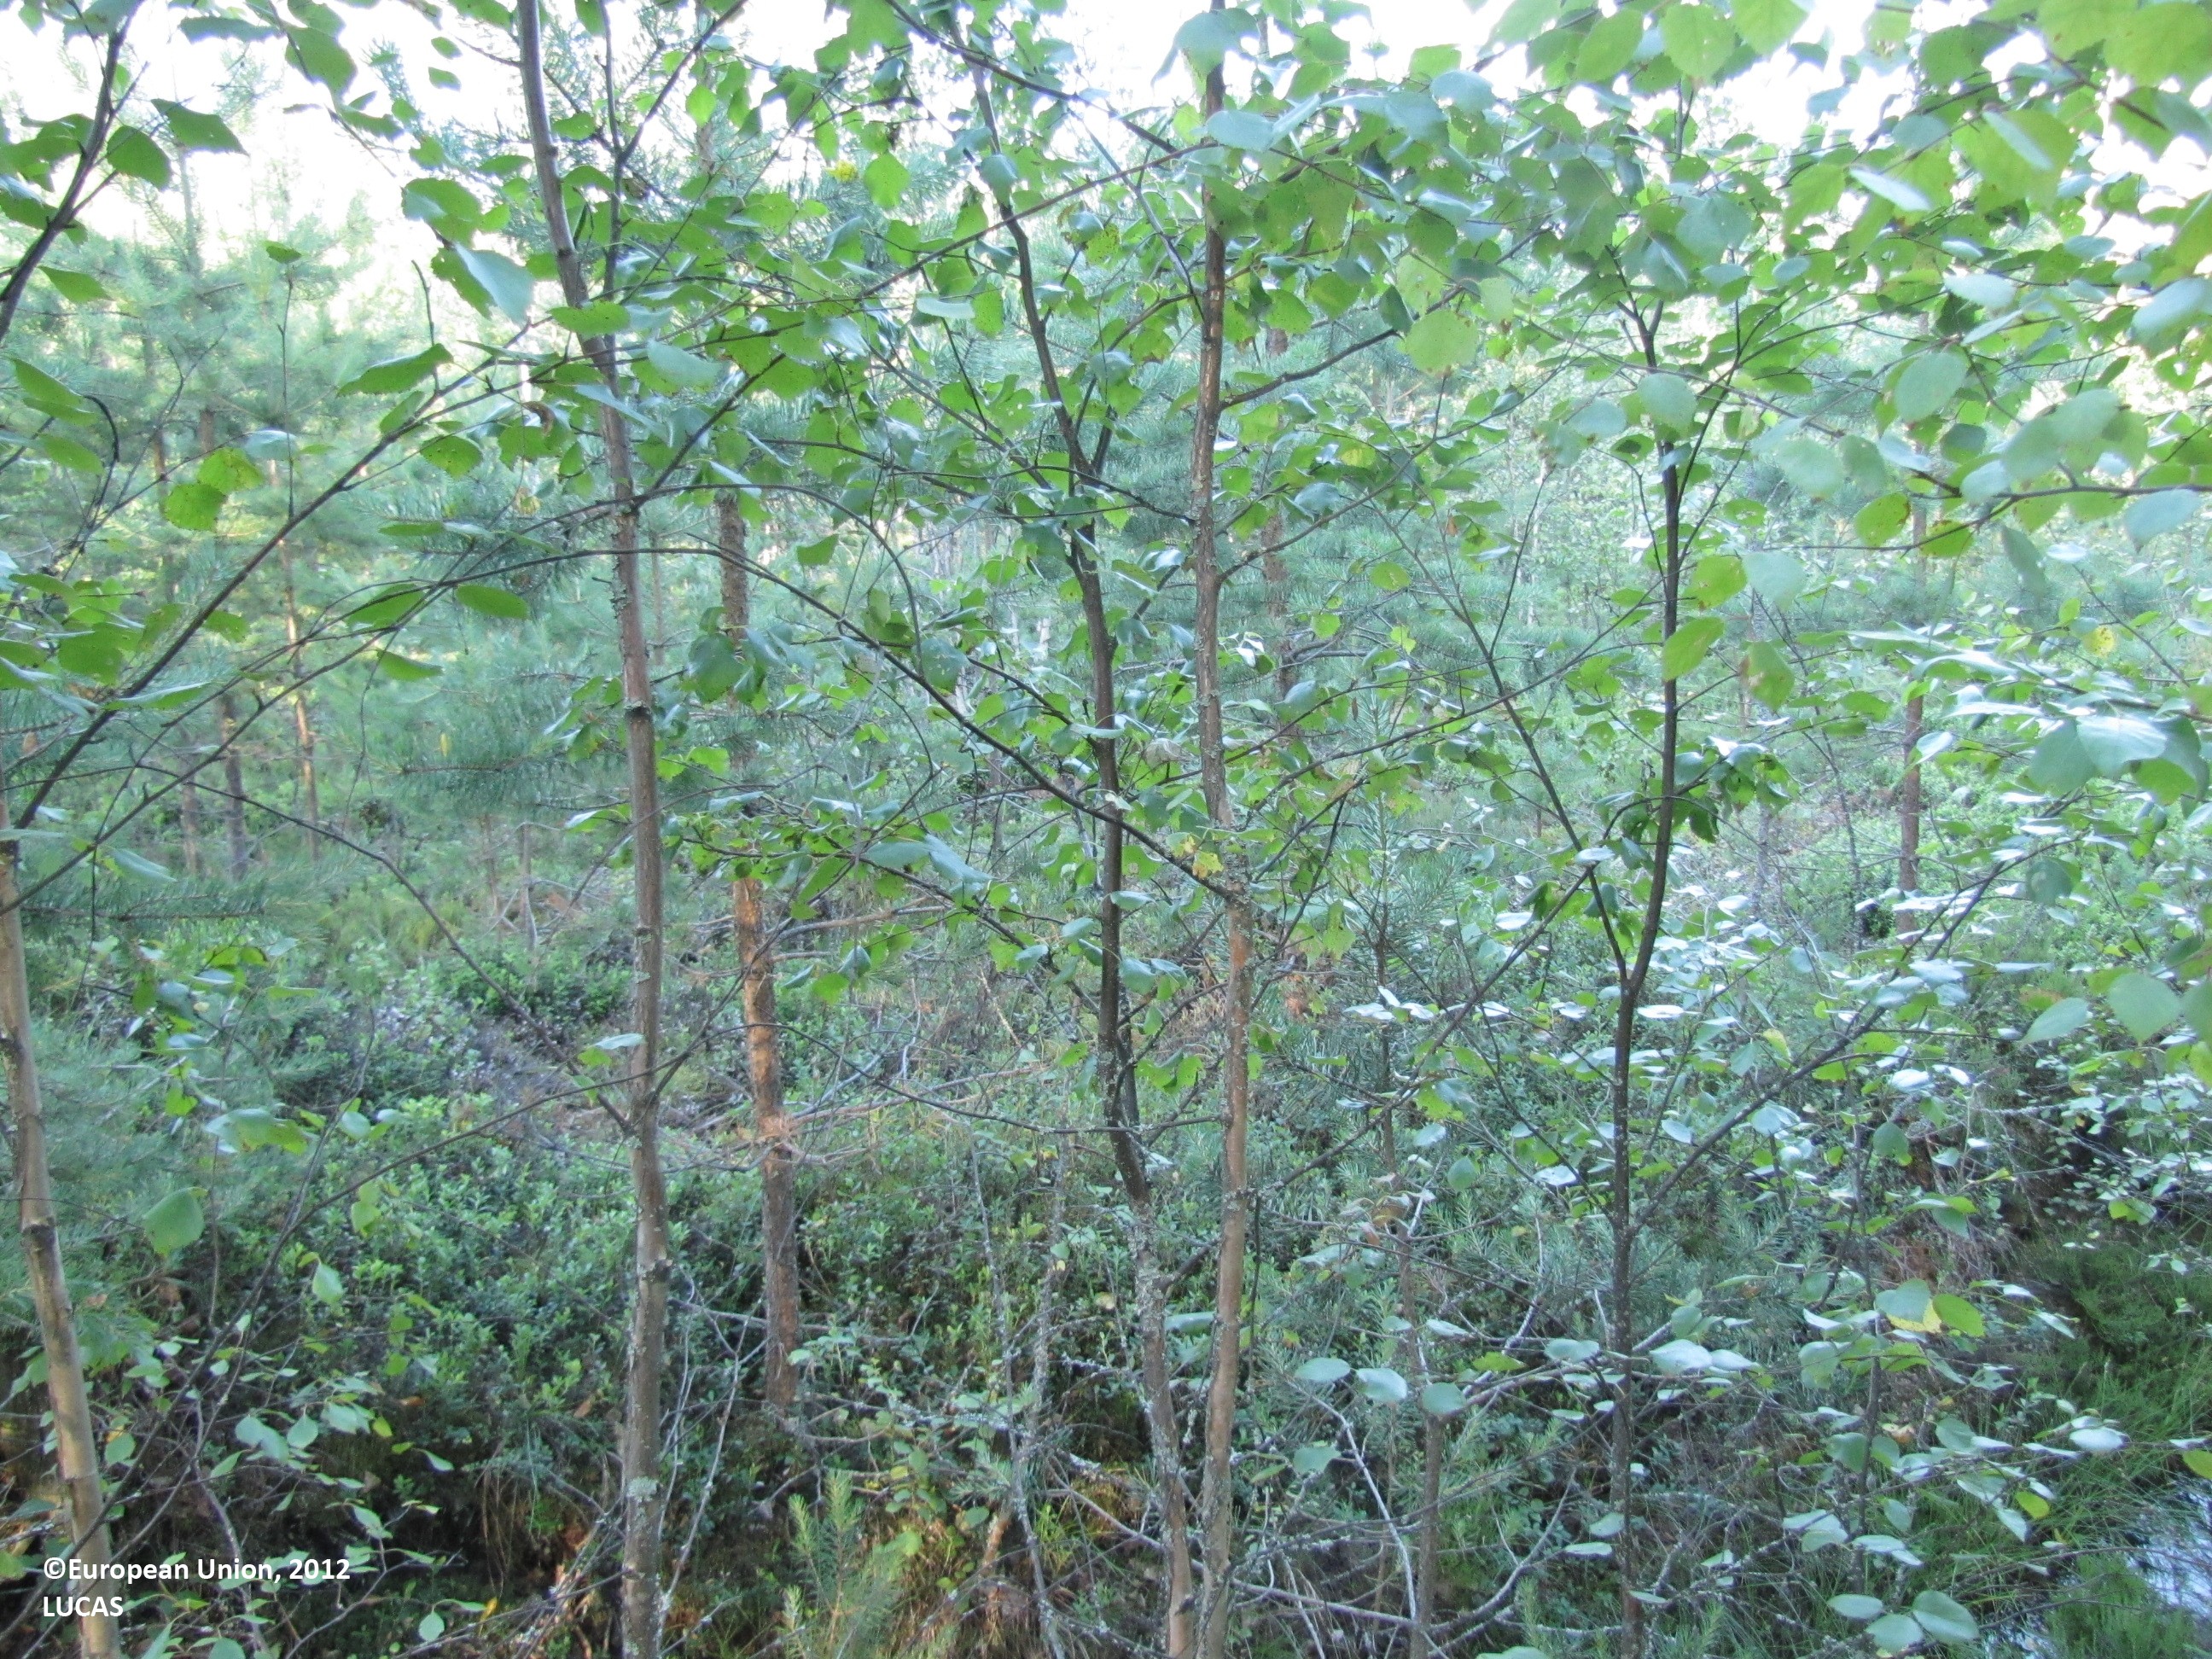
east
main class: Woodland
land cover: Broadleaved woodland
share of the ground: 25 - 50 %
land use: Forestry
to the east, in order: Broadleaved woodland; Ditches and canals; Pine dominated mixed woodland; Sand; Rivers and streams; Sand; Other mixed woodland; Broadleaved woodland; Pine dominated coniferous woodland; Ditches and canals; Abandoned hedges; Grass margins; Paved roads, cycling and walking lanes; Grass margins; Abandoned hedges; Ditches and canals; Other mixed woodland; Other bare soil; Inland marshes; Inland water bodies; Sand; Grassland without tree/shrub cover; Other non-permanent industrial crops
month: July
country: FI
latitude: 62.5104
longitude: 23.1342
